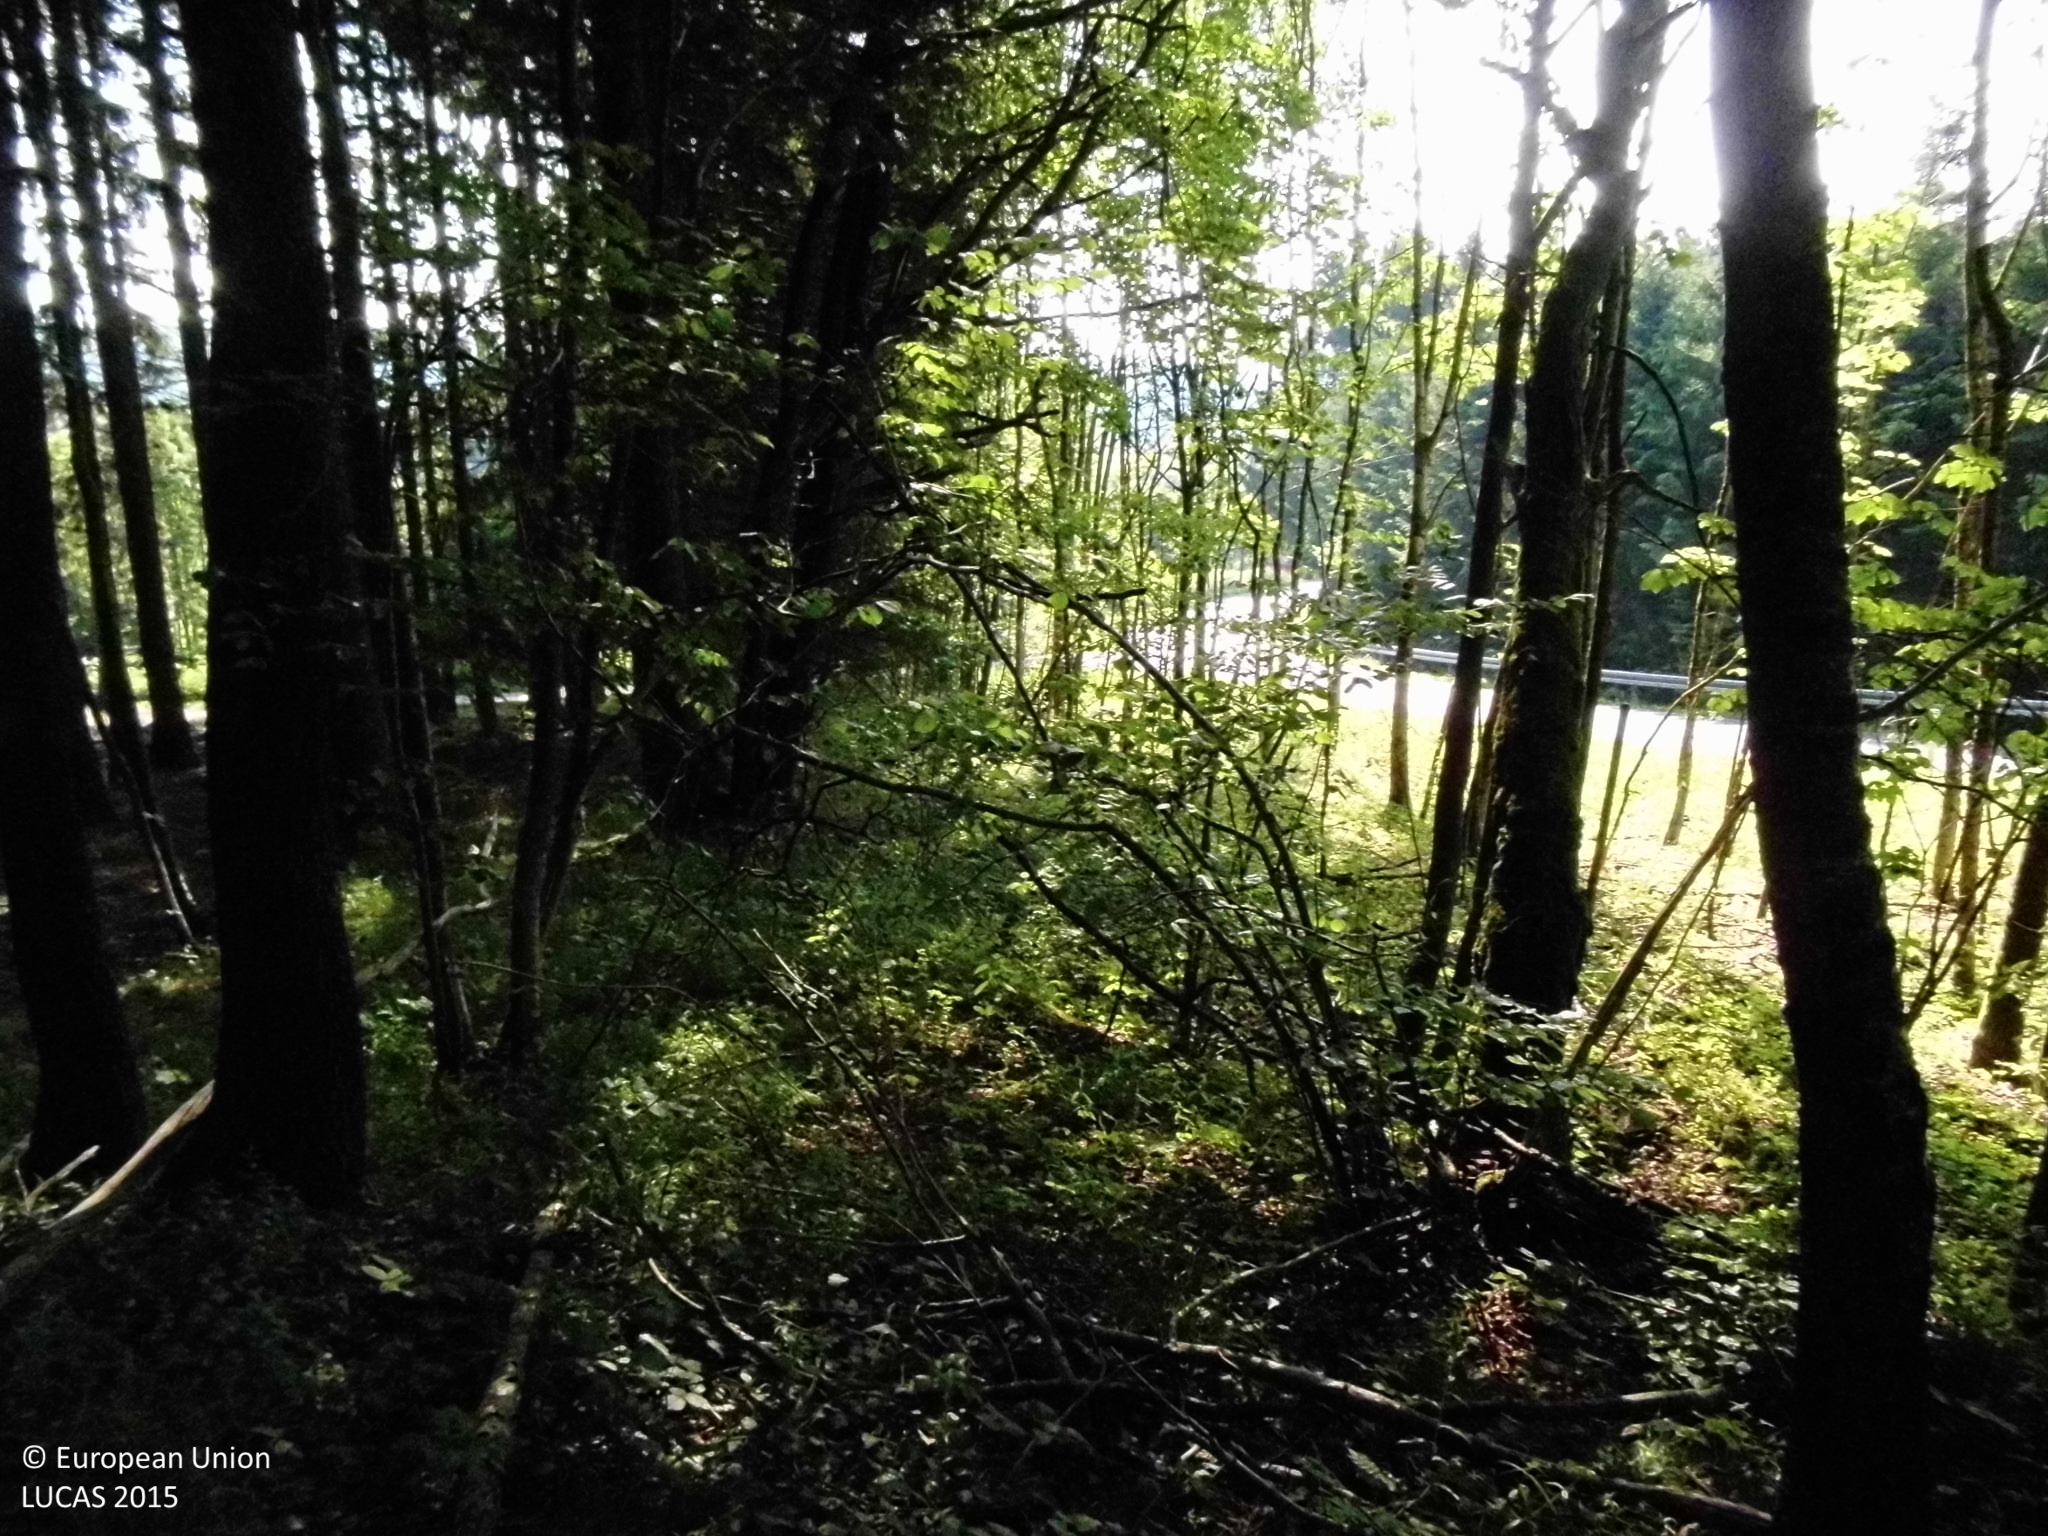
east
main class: Woodland
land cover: Broadleaved woodland
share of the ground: > 75 %
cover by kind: broadleaved forest trees 95 %, herbaceous plants 5 %
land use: Forestry
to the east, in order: Broadleaved woodland; Spruce dominated coniferous woodland; Broadleaved woodland; Shruby margins; Paved roads, cycling and walking lanes; Broadleaved woodland; Grassland without tree/shrub cover; Tracks; Shruby margins; Fences; Spontaneously vegetated surfaces; Nurseries; Spontaneously vegetated surfaces; Fences; Grassland without tree/shrub cover; Spruce dominated coniferous woodland
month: July
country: DE
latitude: 51.2455
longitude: 7.9804
